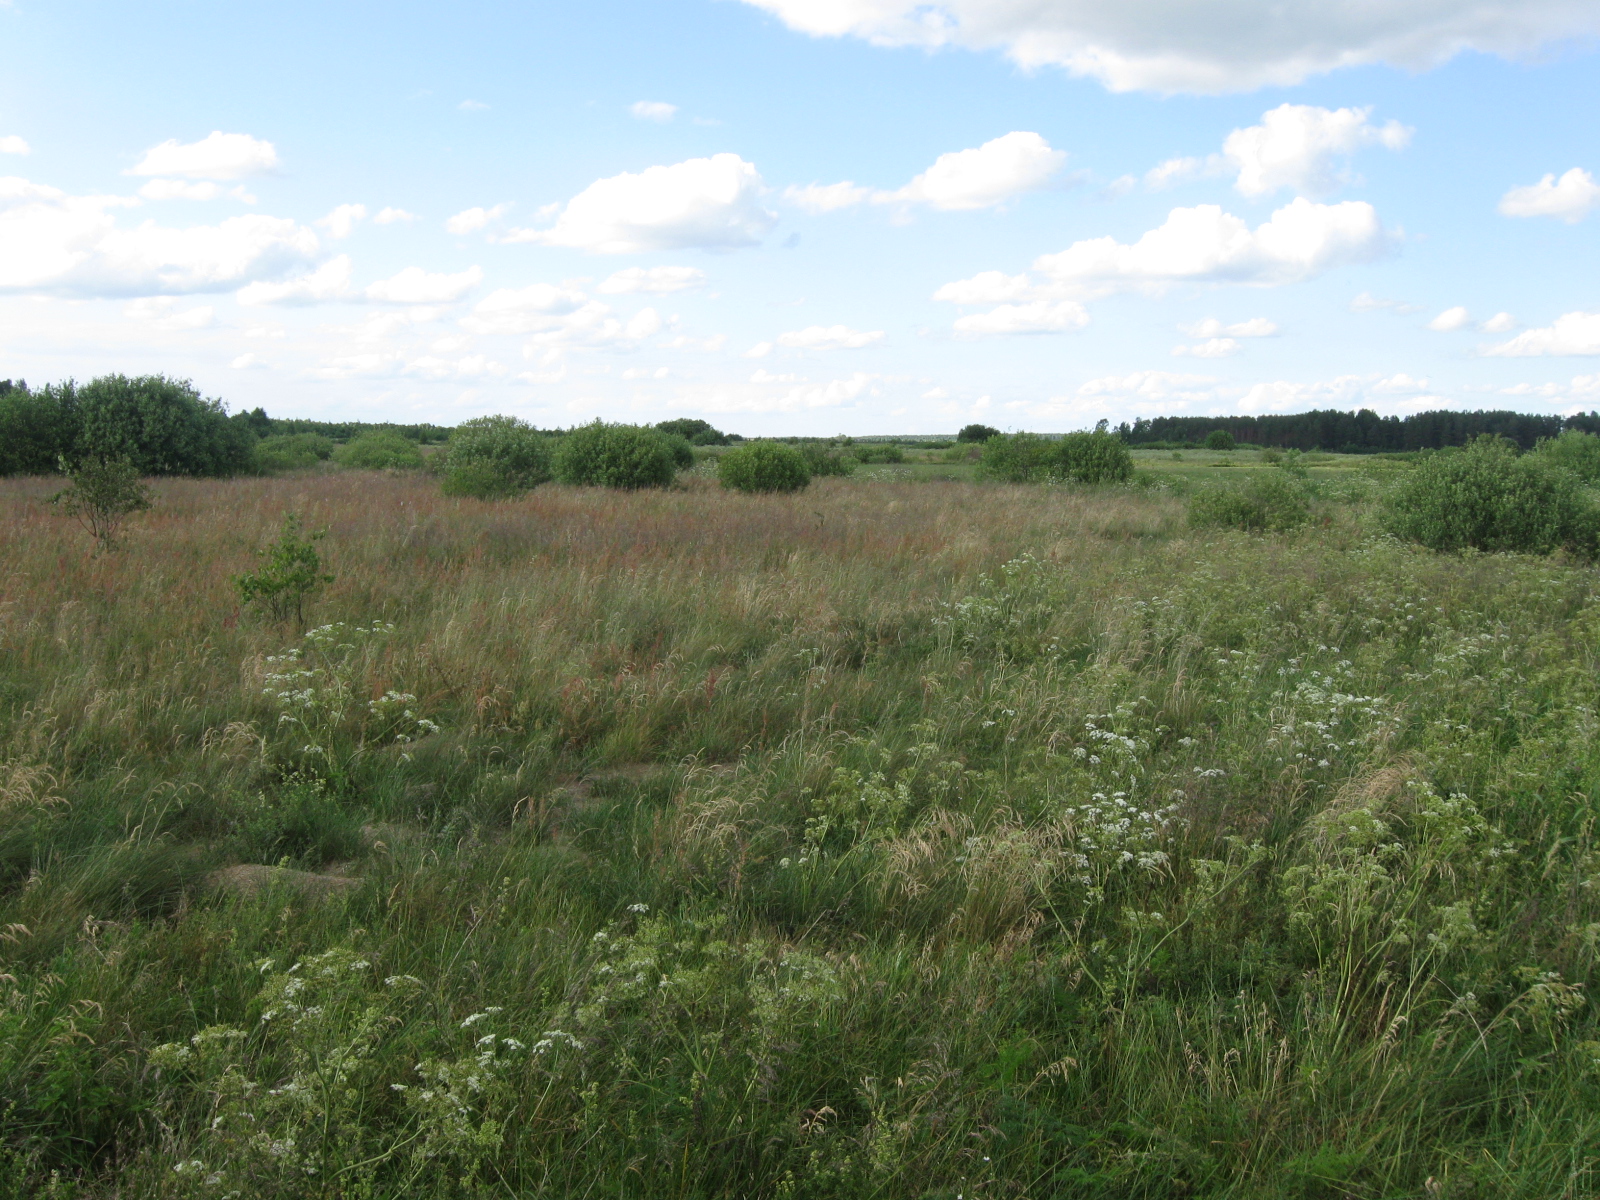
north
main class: Grassland
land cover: Spontaneously vegetated surfaces
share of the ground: > 75 %
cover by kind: herbaceous plants 100 %
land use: Fallow land
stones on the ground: < 10 %
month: June
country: LT
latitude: 54.4540
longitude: 24.7147
